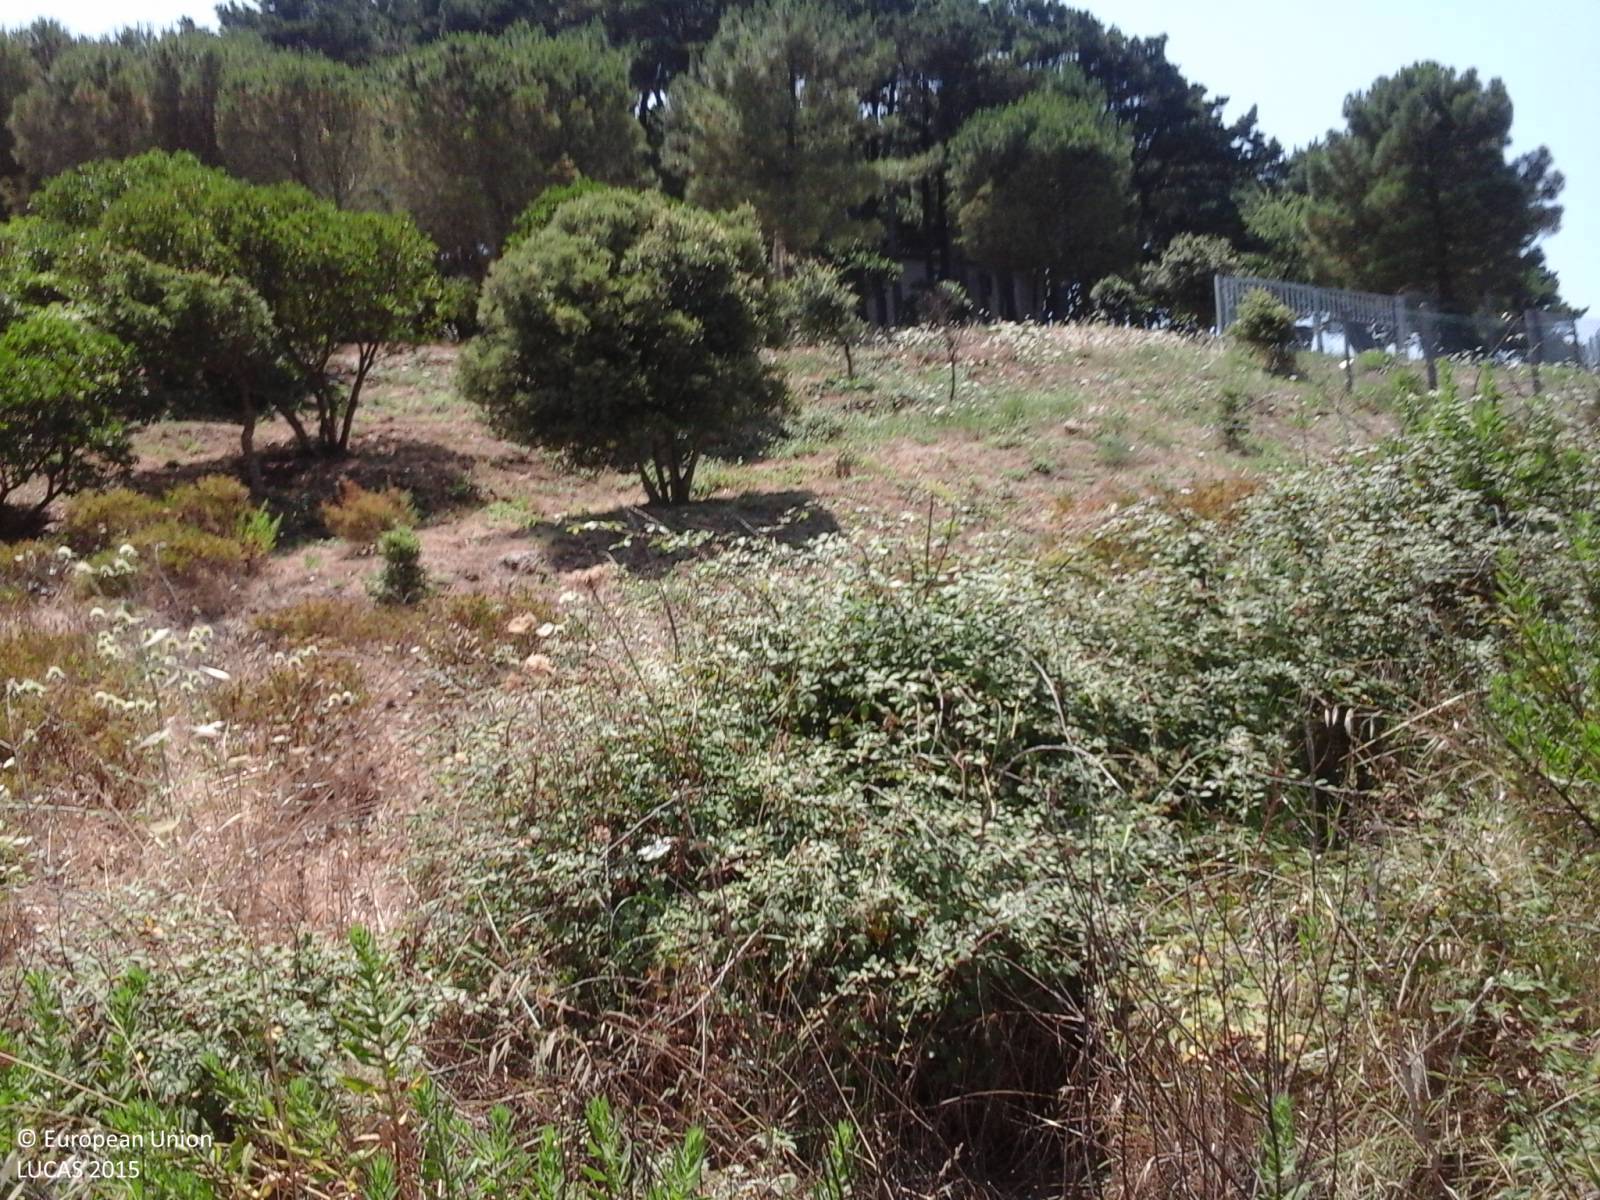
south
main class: Shrubland
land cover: Shrubland without tree cover
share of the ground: > 75 %
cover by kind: shrubs 100 %
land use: Semi-natural and natural areas not in use
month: July
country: IT
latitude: 39.9344
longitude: 8.8246
